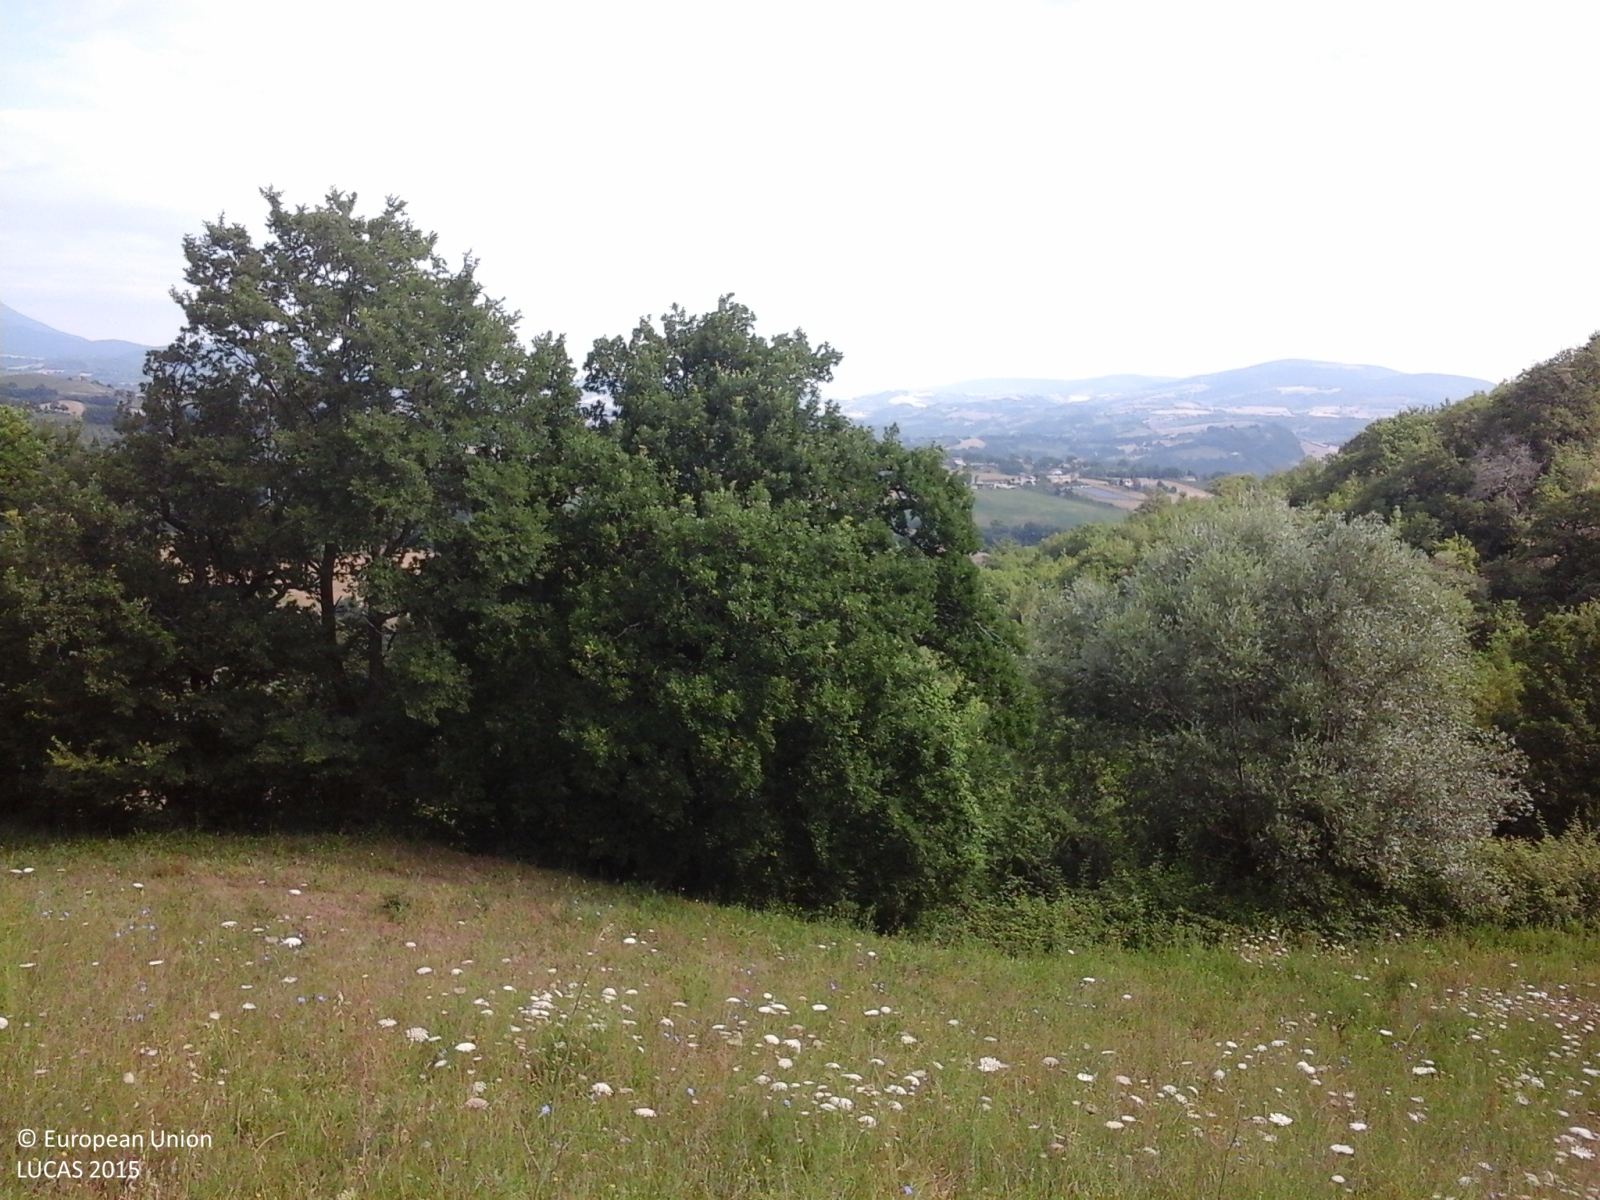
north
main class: Grassland
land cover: Spontaneously vegetated surfaces
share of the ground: > 75 %
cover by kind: herbaceous plants 95 %, shrubs 5 %
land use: Agriculture (excluding fallow land and kitchen gardens)
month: June
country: IT
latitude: 43.1997
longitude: 13.2034
